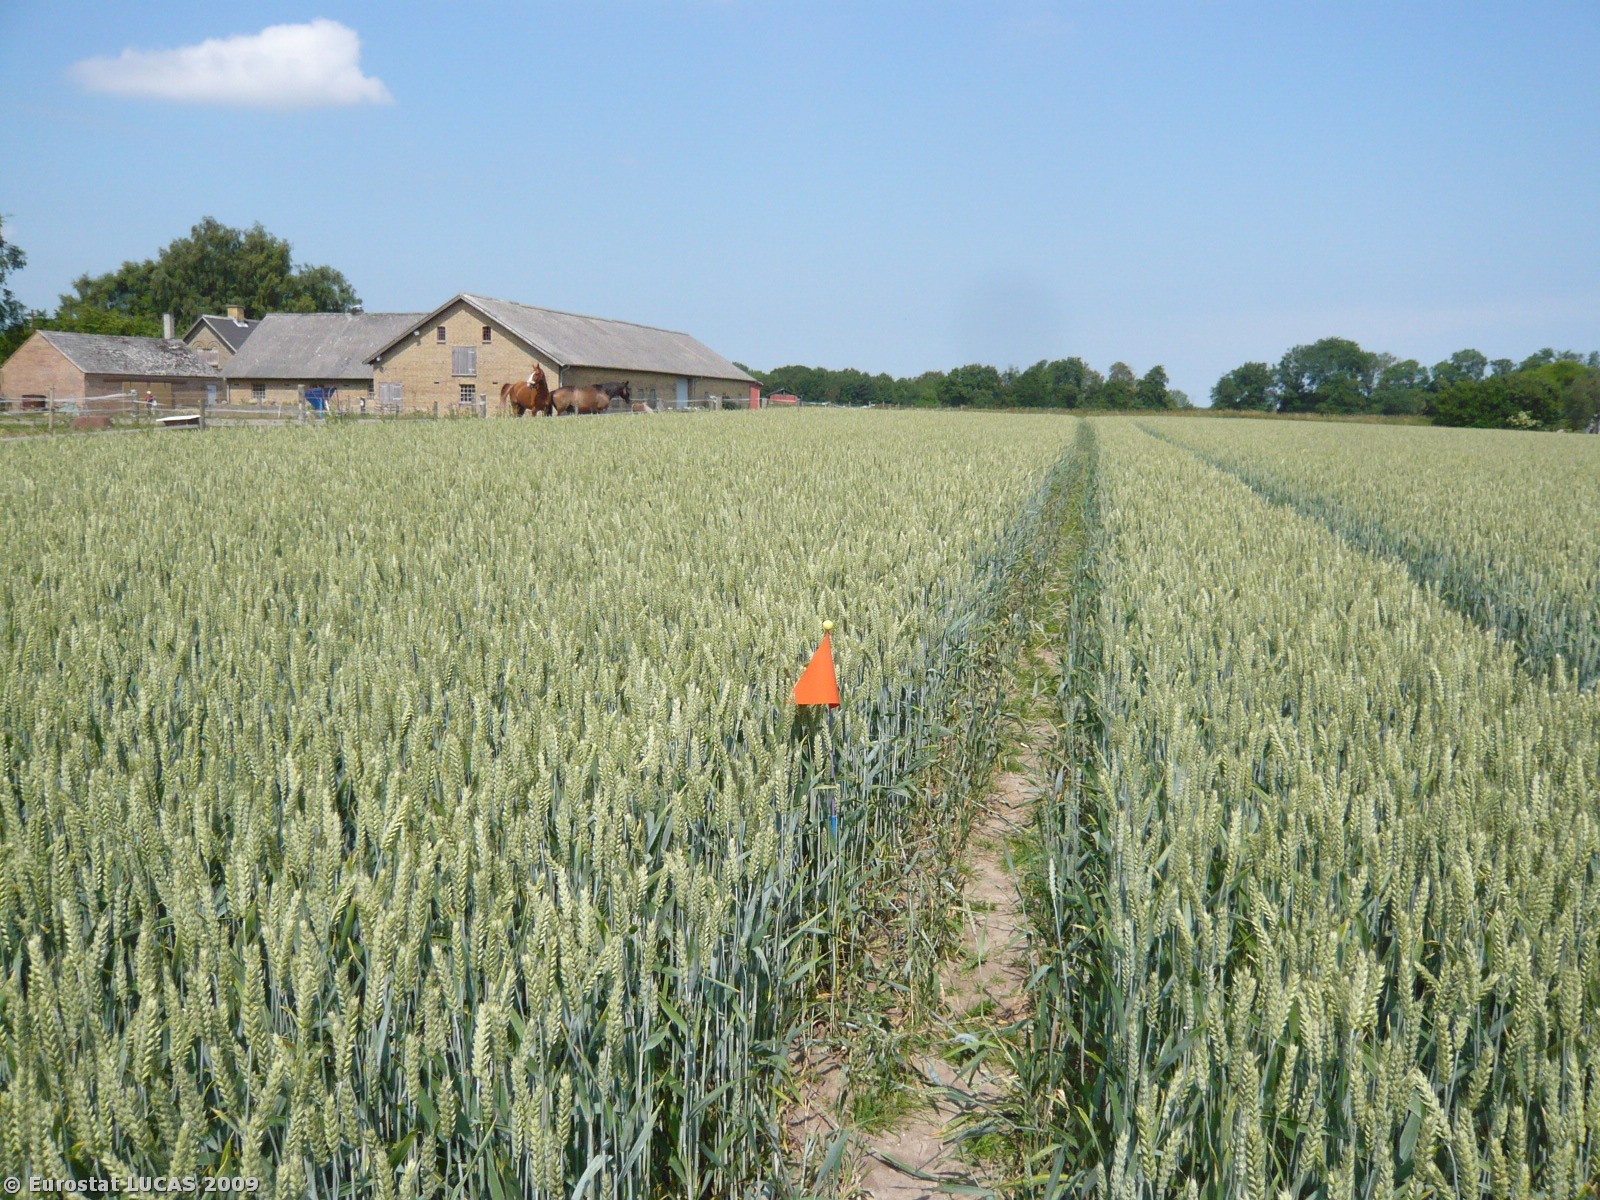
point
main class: Cropland
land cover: Common wheat
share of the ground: > 75 %
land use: Agriculture (excluding fallow land and kitchen gardens)
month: June
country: DK
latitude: 55.2874
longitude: 10.6450
